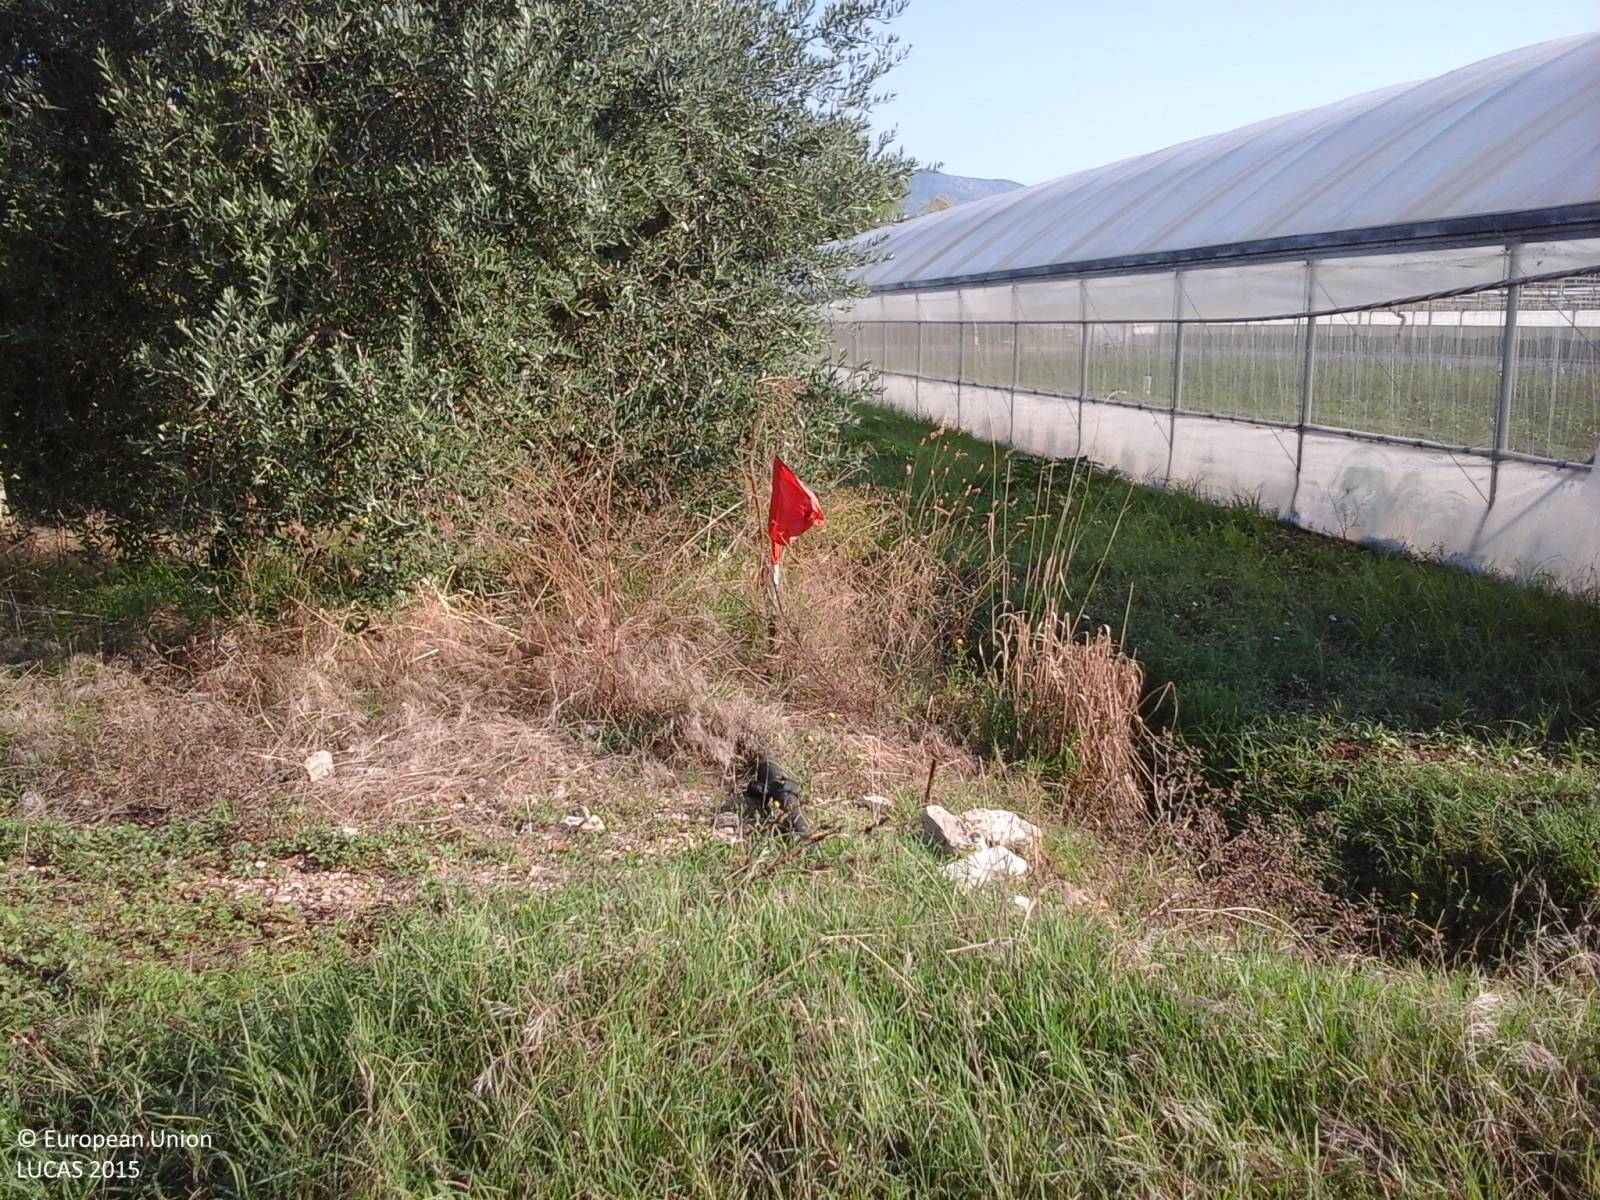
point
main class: Cropland
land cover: Olive groves
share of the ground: > 75 %
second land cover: Spontaneously vegetated surfaces
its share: > 75 %
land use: Agriculture (excluding fallow land and kitchen gardens)
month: August
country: IT
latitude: 41.3321
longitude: 13.3680
